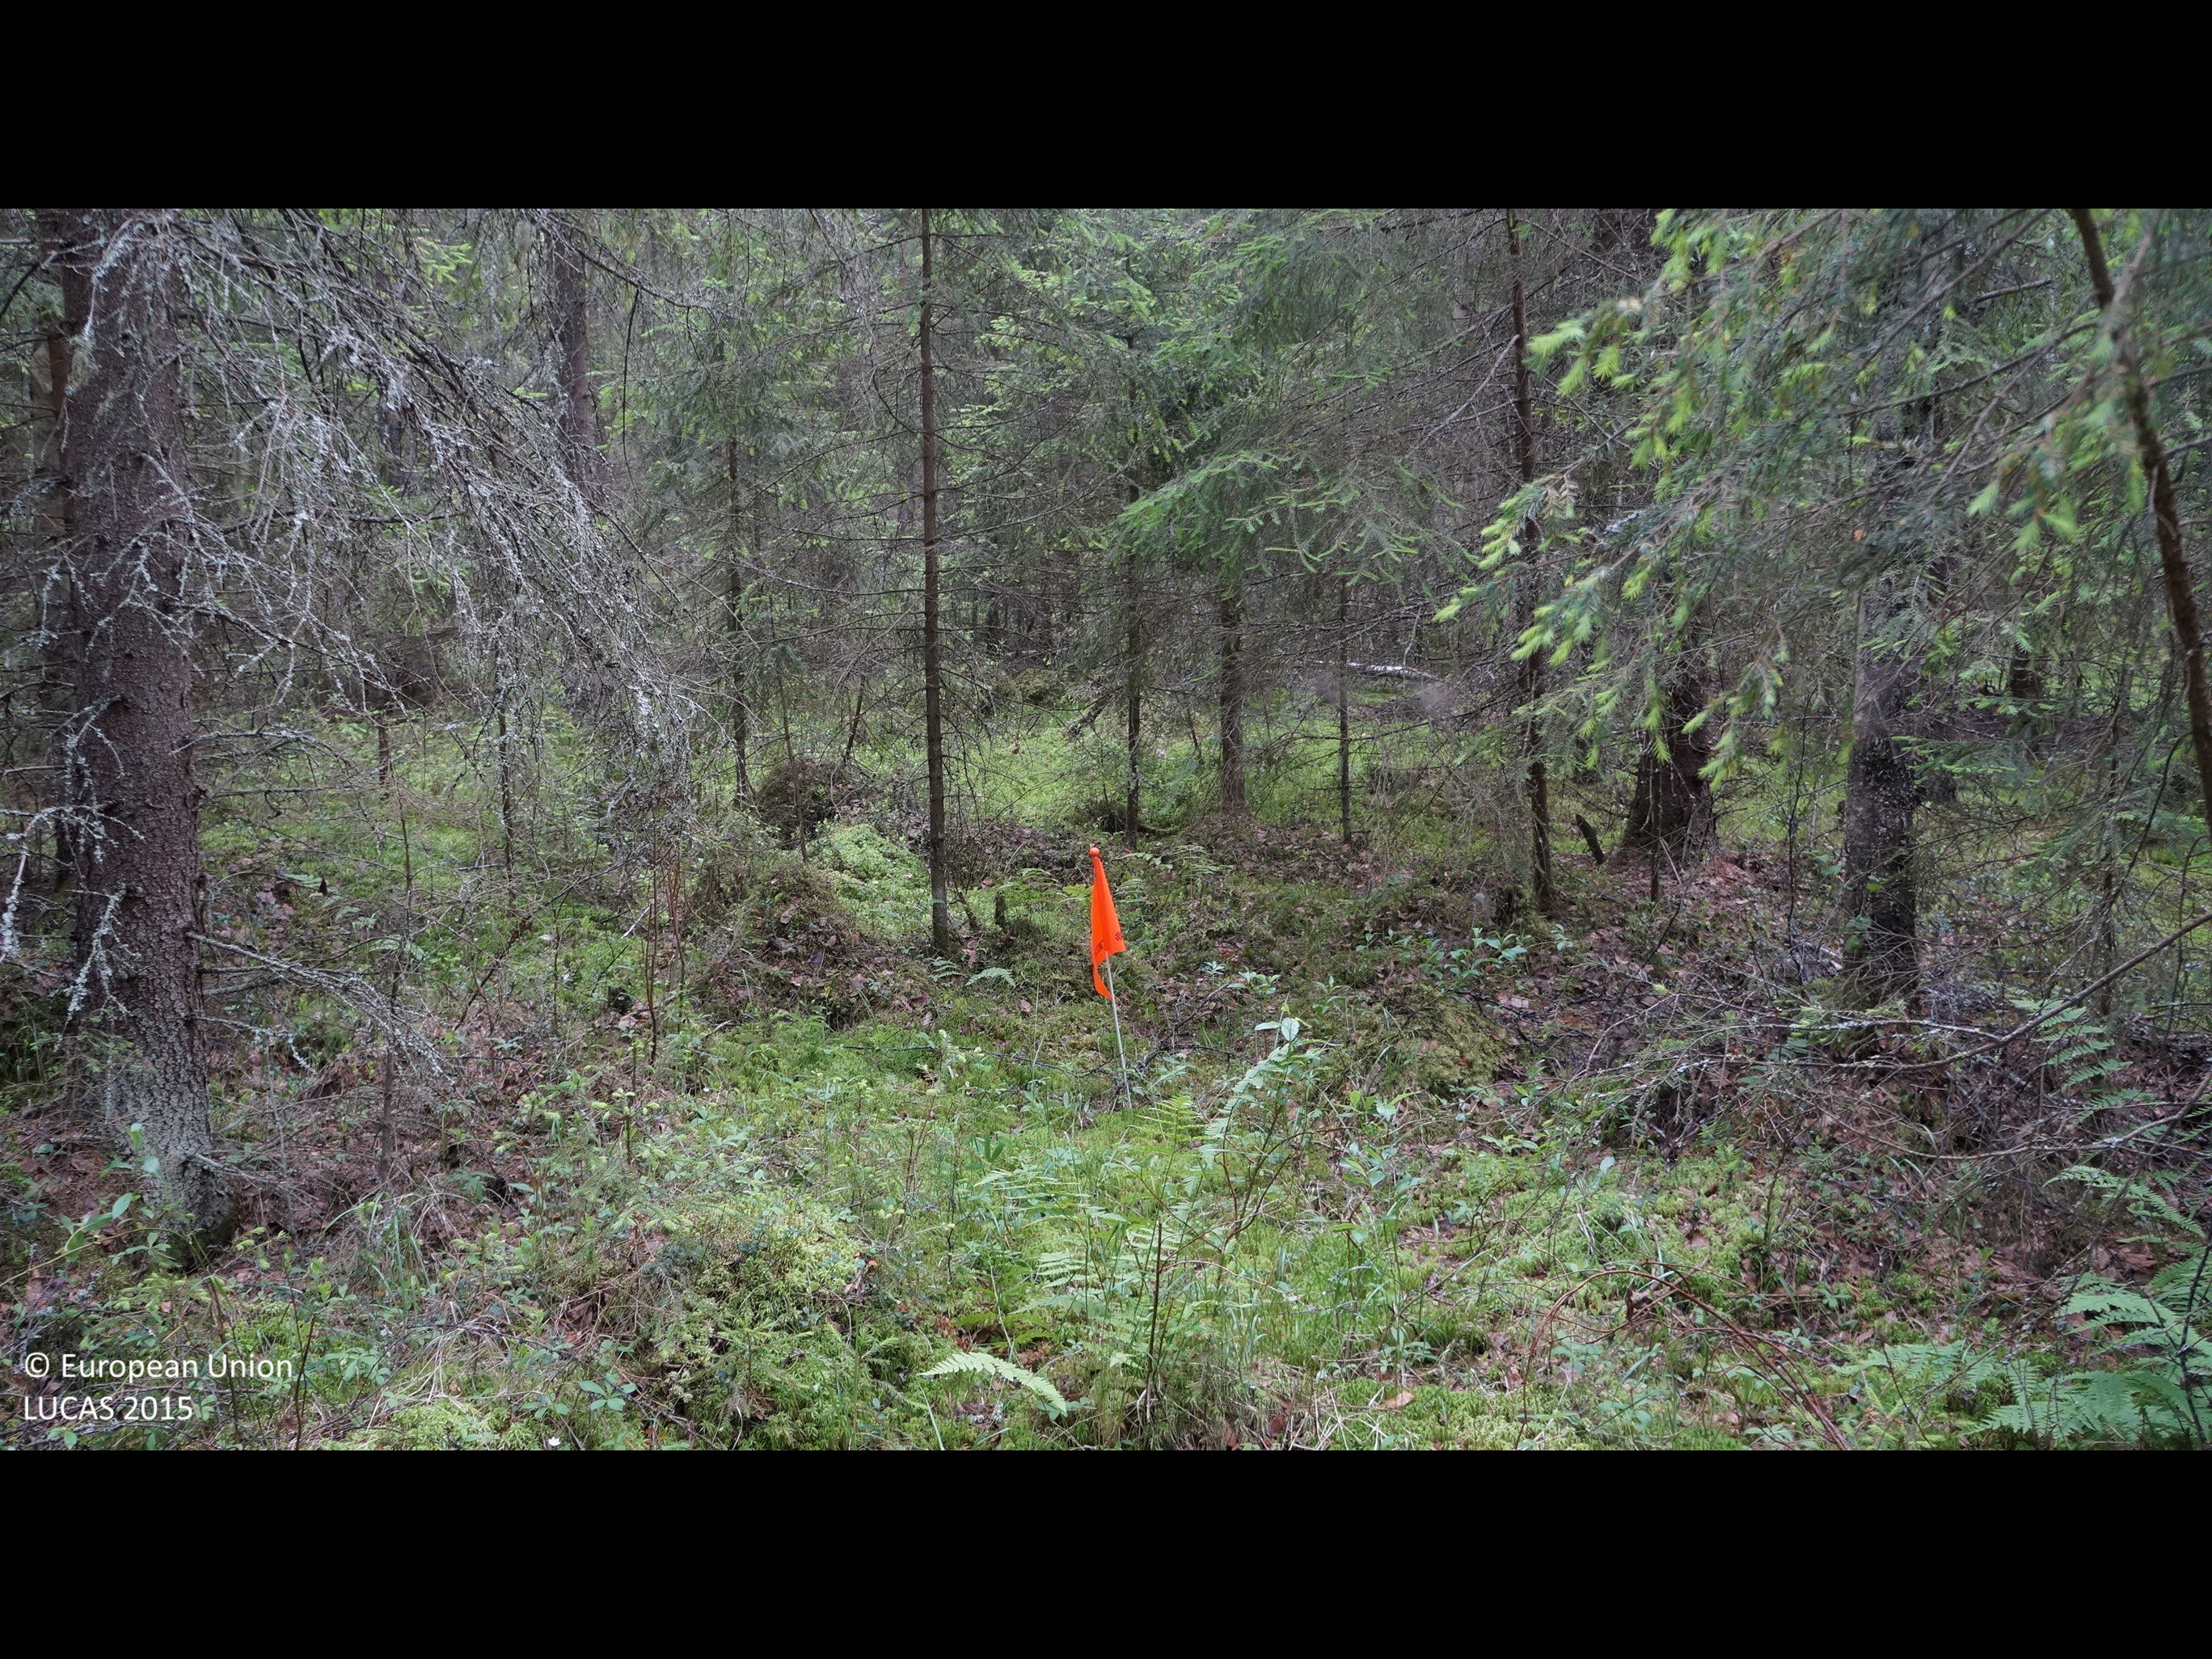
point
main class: Woodland
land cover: Spruce dominated mixed woodland
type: boreal forest
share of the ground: > 75 %
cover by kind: coniferous forest trees 45 %, broadleaved forest trees 30 %, shrubs 10 %, lichens and mosses 10 %, herbaceous plants 5 %
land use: Forestry
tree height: > 5 m
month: June
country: FI
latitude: 64.2137
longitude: 24.2215
